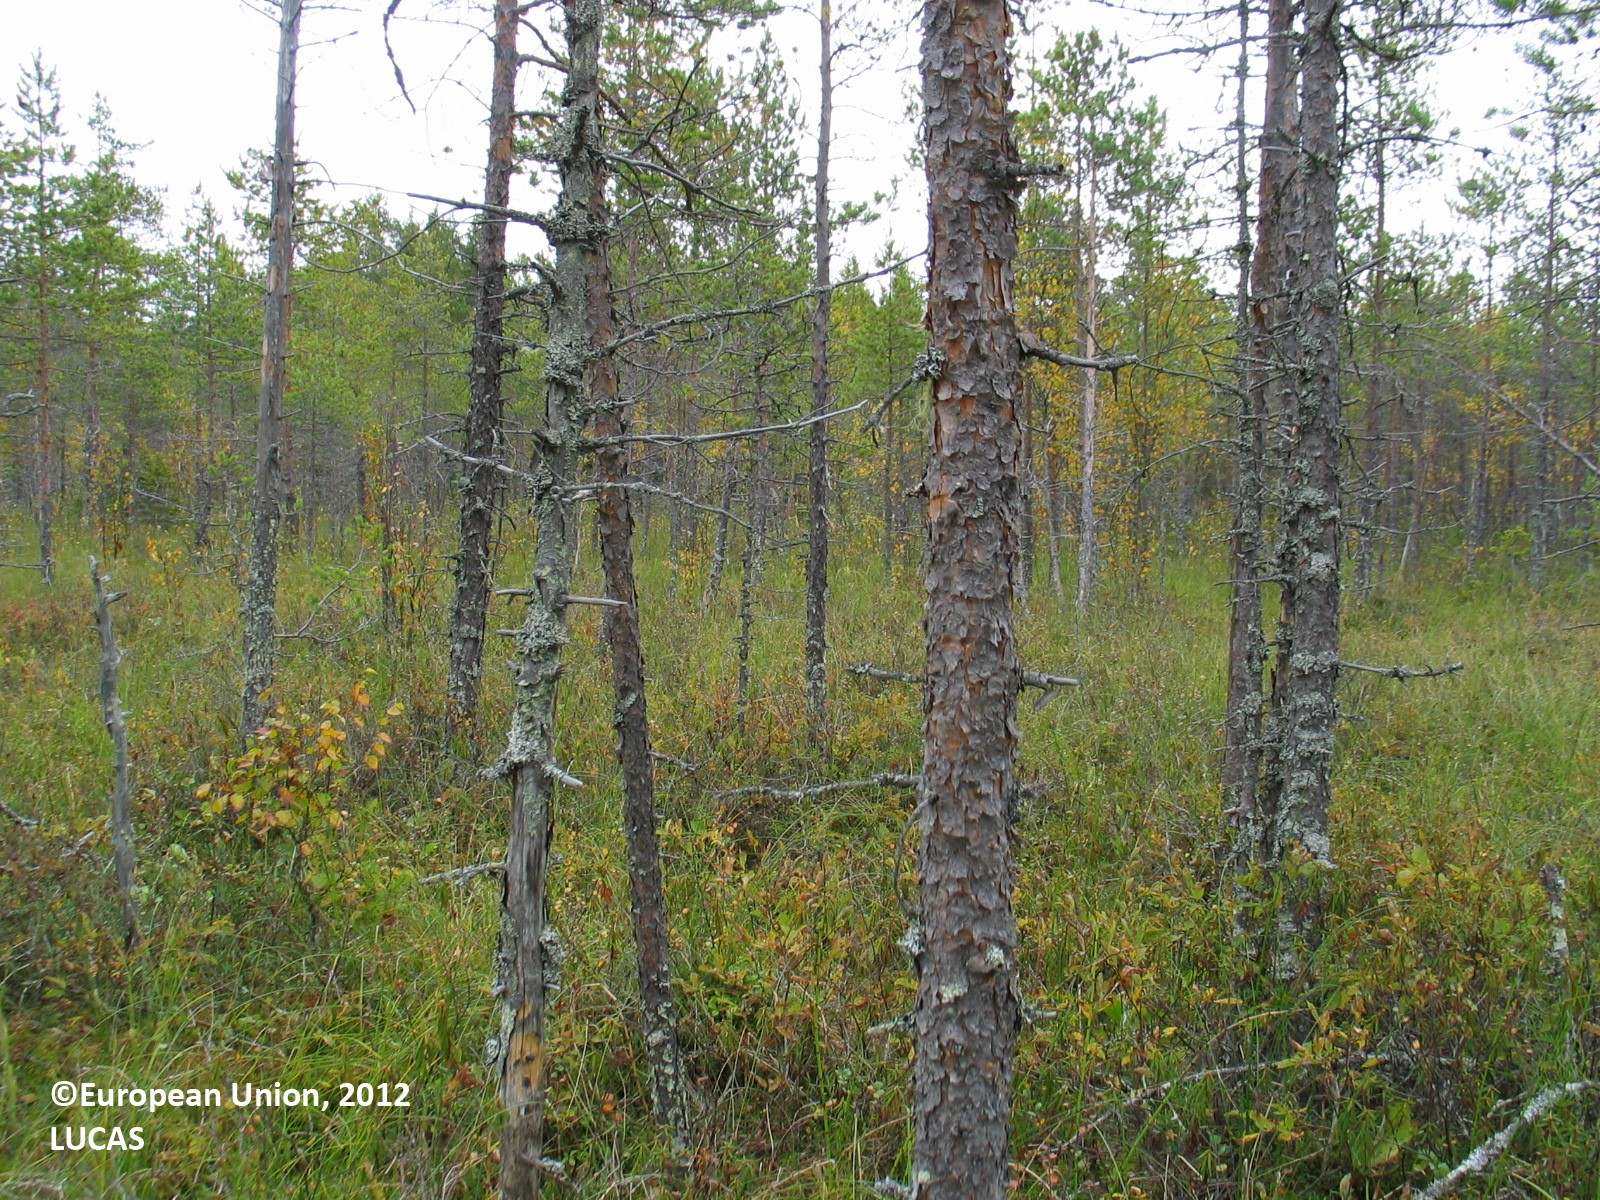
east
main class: Woodland
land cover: Pine dominated coniferous woodland
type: mire and swamp forests
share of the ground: 25 - 50 %
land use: Forestry
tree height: > 5 m
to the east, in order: Pine dominated coniferous woodland; Other mixed woodland; Pine dominated coniferous woodland; Ditches and canals; Pine dominated coniferous woodland; Ditches and canals; Pine dominated coniferous woodland; Tracks; Ditches and canals; Pine dominated mixed woodland
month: September
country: FI
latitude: 65.6053
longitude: 25.1492
